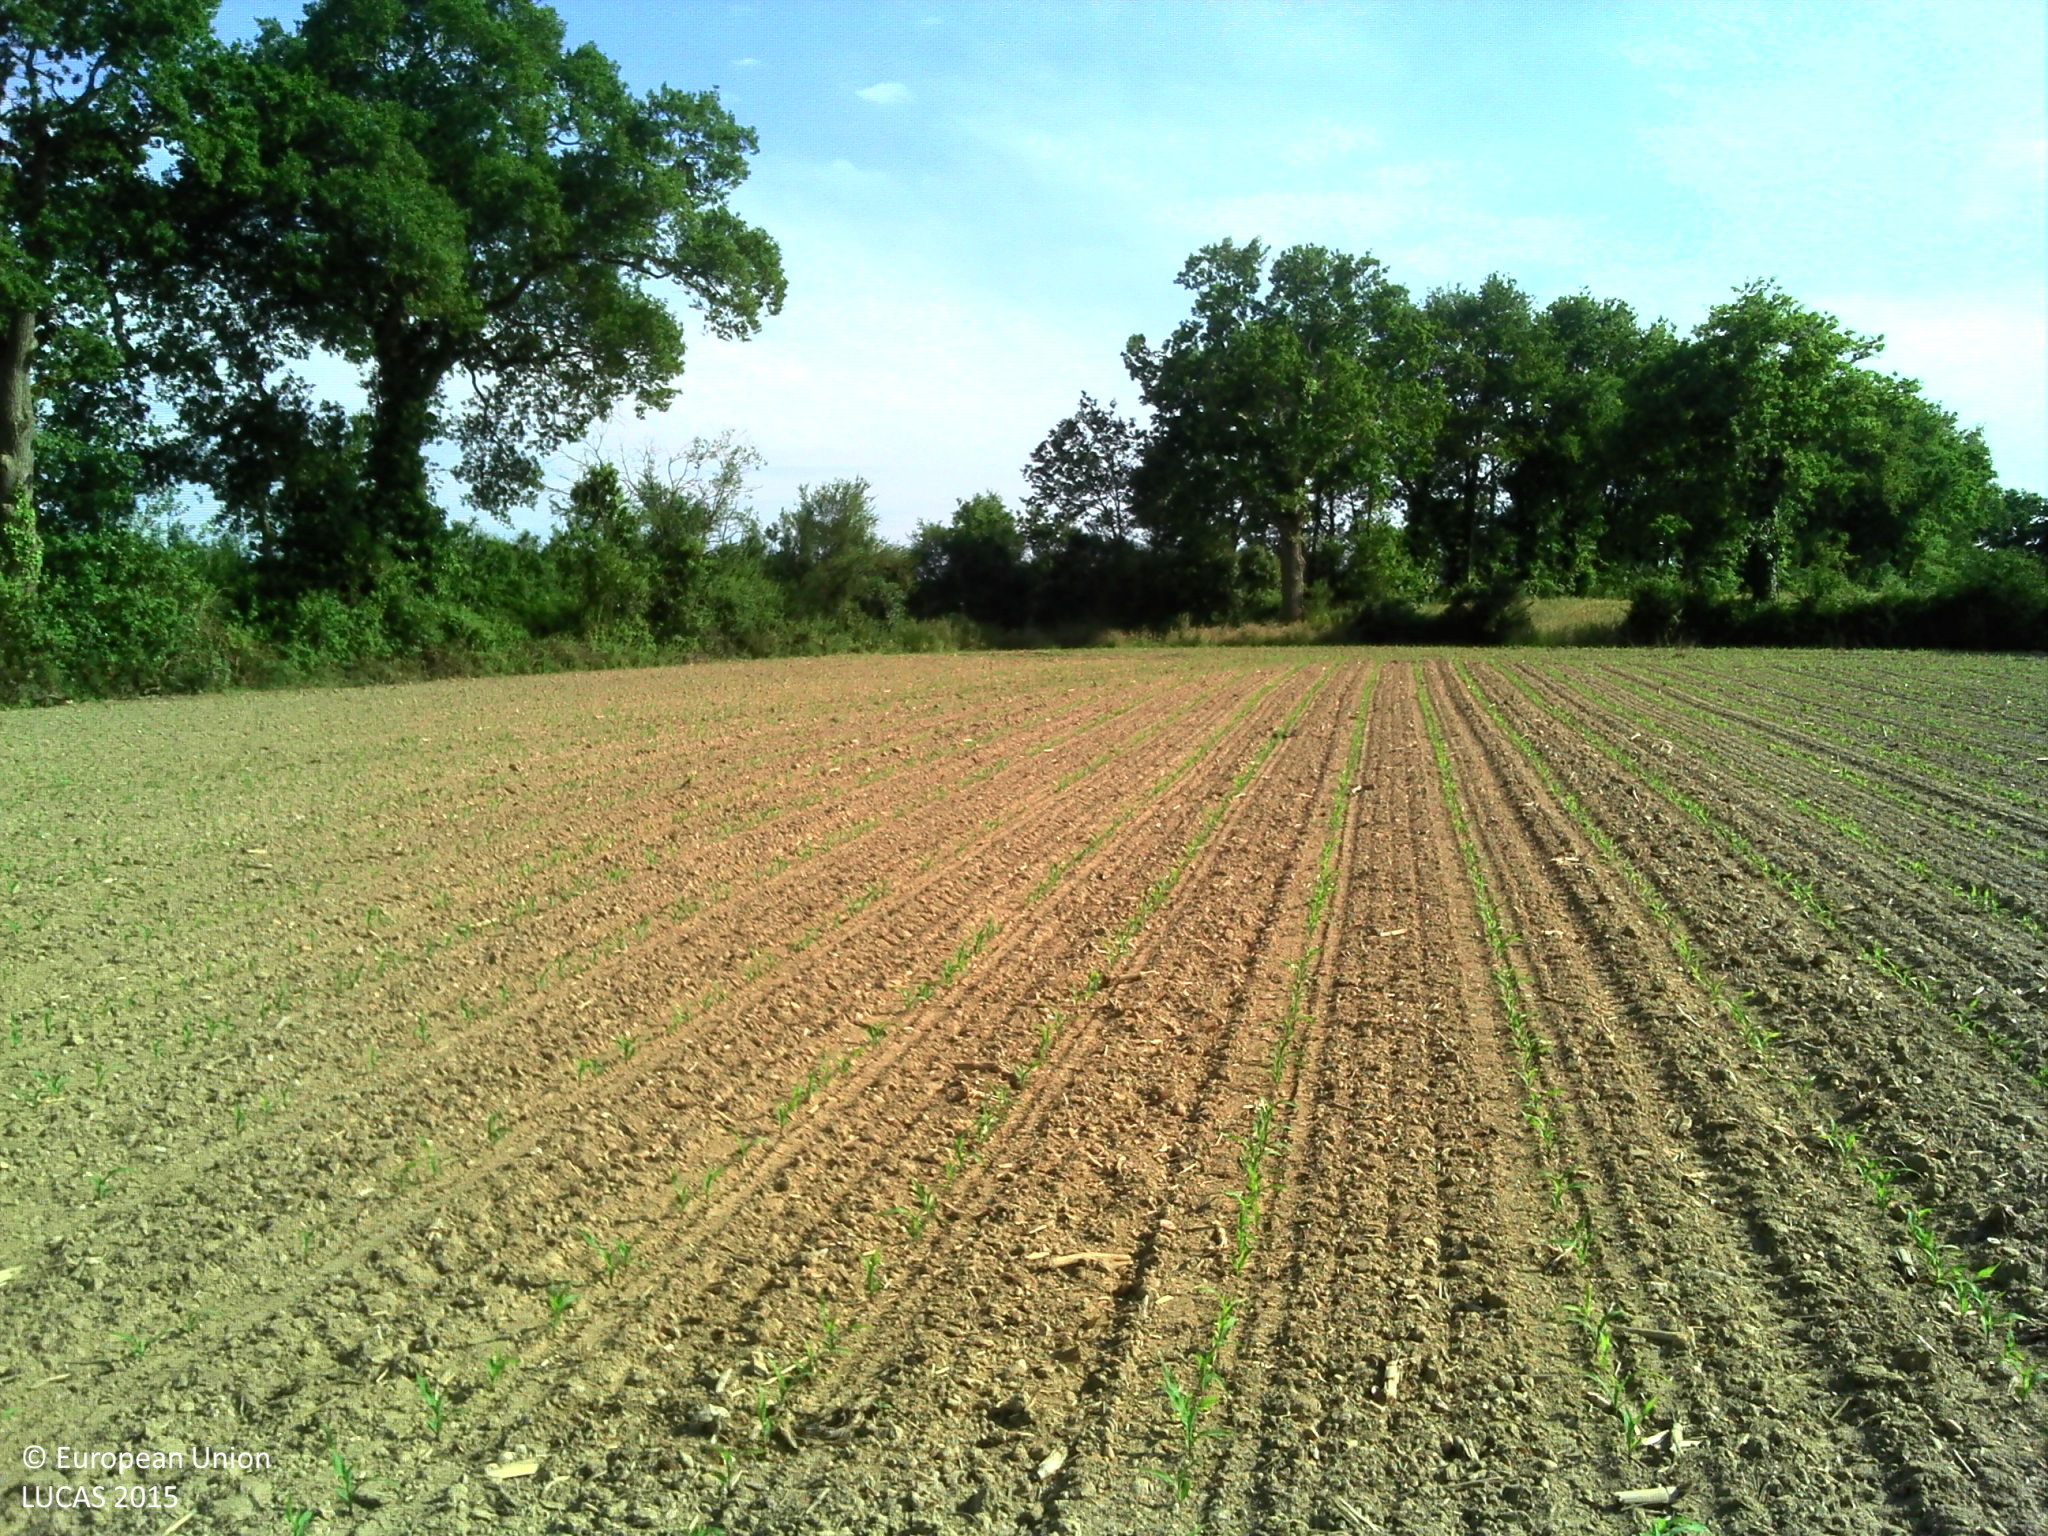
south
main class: Cropland
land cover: Maize
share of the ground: < 10 %
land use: Agriculture (excluding fallow land and kitchen gardens)
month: June
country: FR
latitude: 46.8645
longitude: -1.7574
